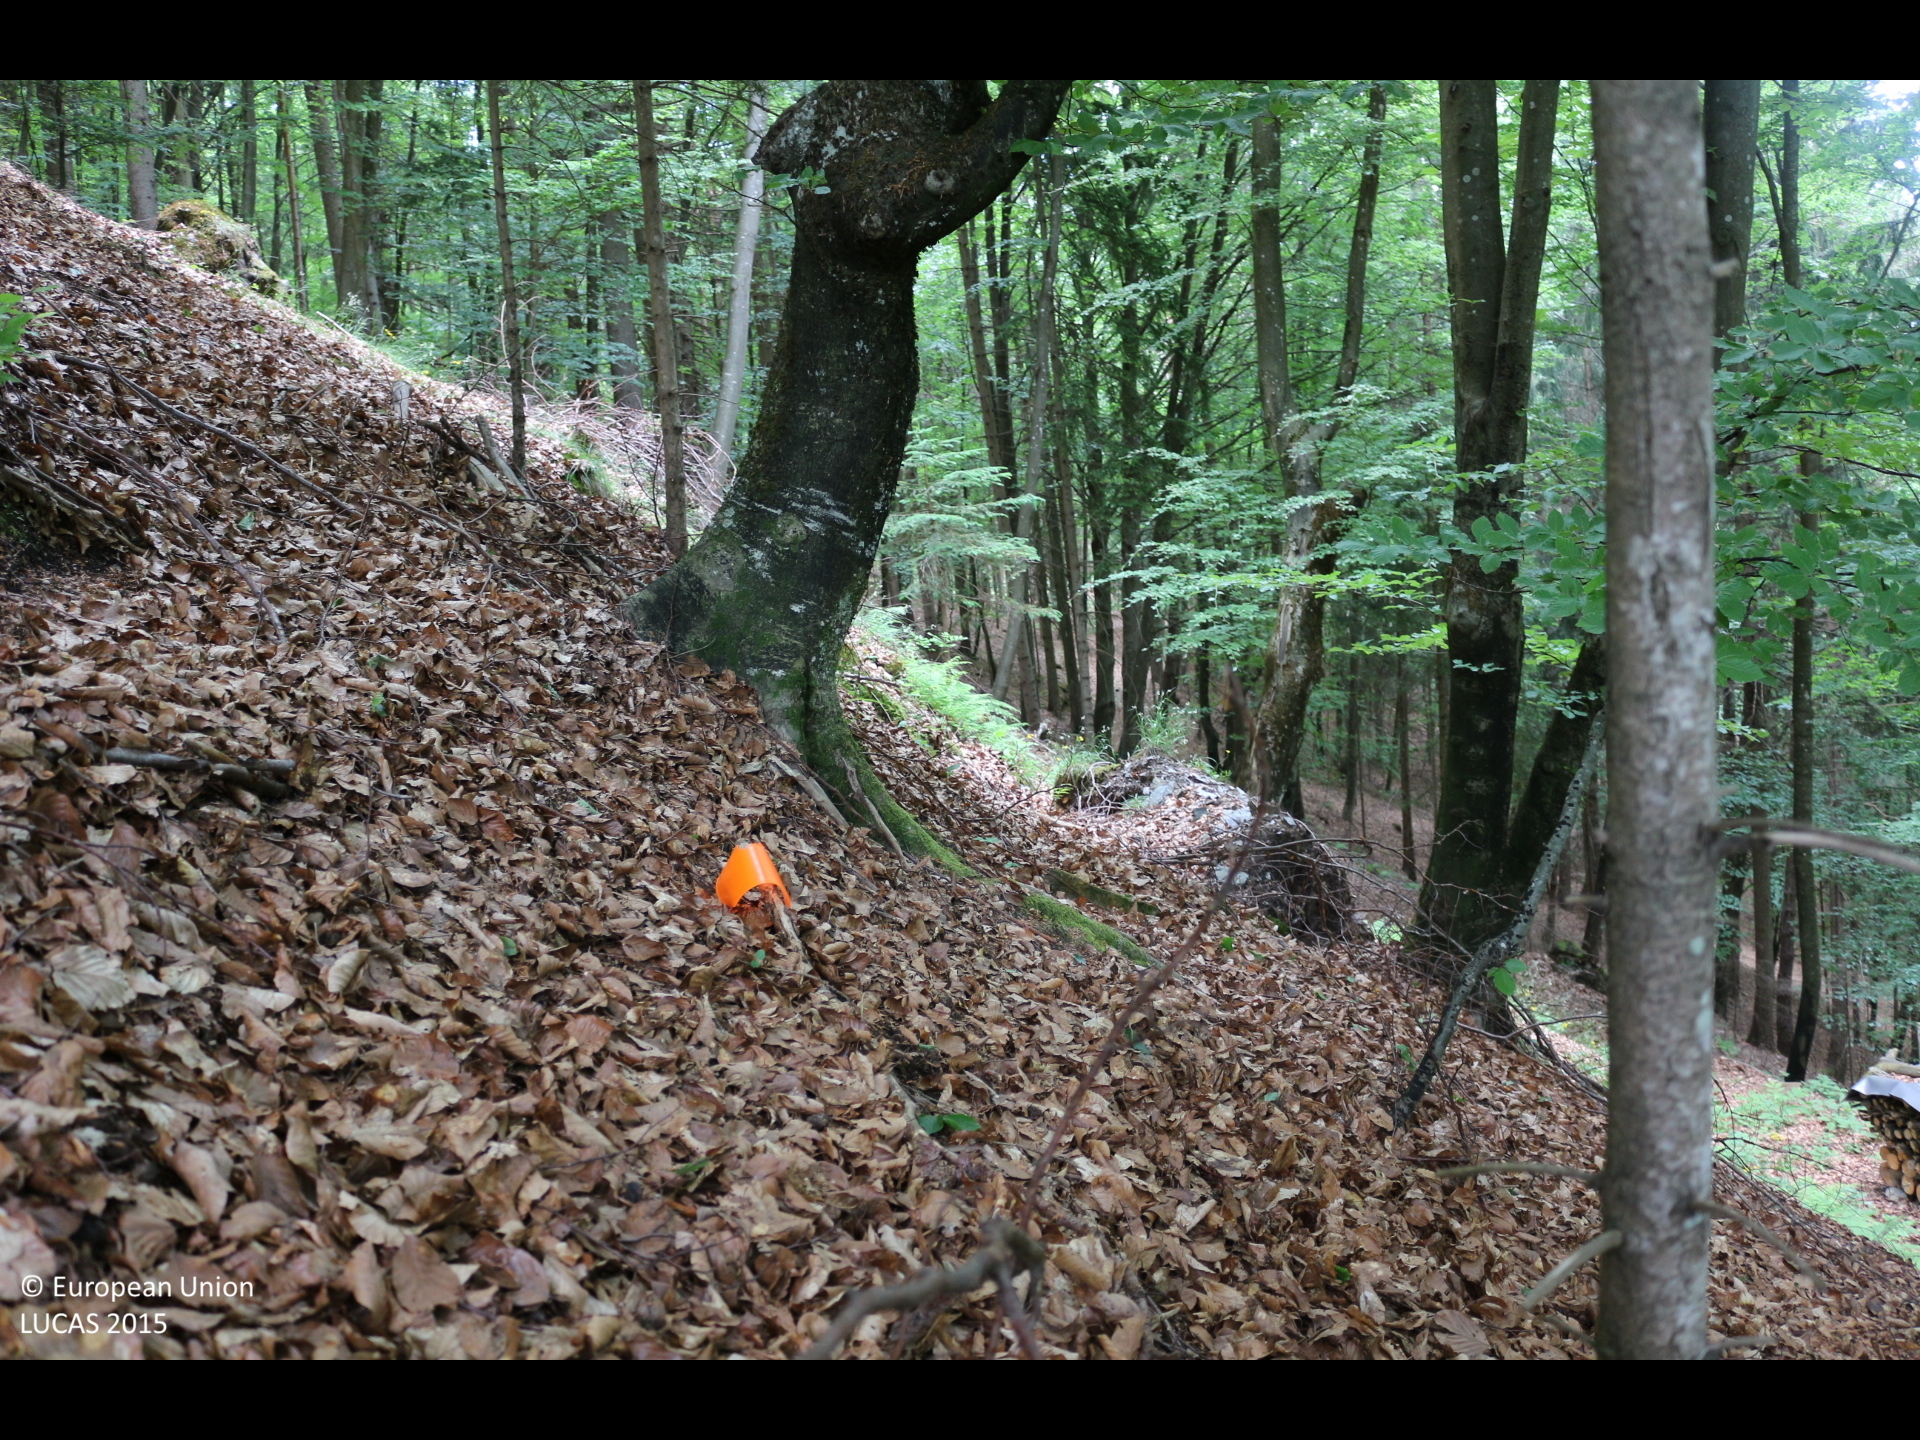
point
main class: Woodland
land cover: Broadleaved woodland
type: mountainous beech forest
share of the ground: > 75 %
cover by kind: broadleaved forest trees 80 %, coniferous forest trees 20 %
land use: Forestry
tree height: > 5 m
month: May
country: AT
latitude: 46.6858
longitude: 14.5871
